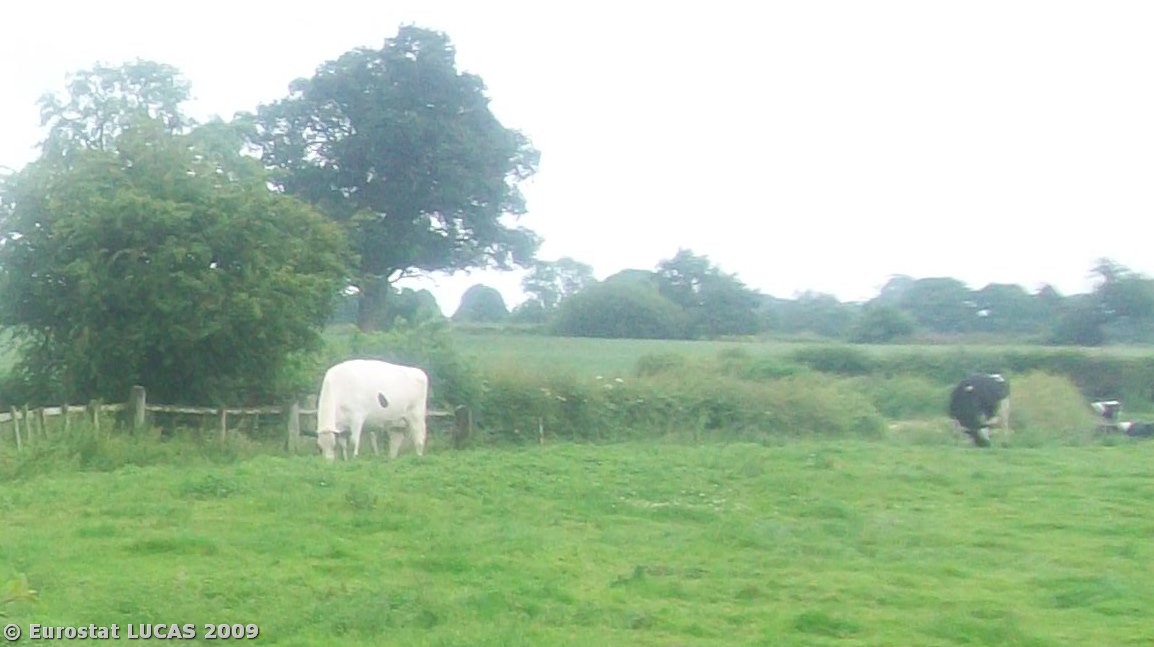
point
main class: Grassland
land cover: Grassland without tree/shrub cover
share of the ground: > 75 %
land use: Agriculture (excluding fallow land and kitchen gardens)
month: July
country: GB
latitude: 52.9333
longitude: -2.6703
